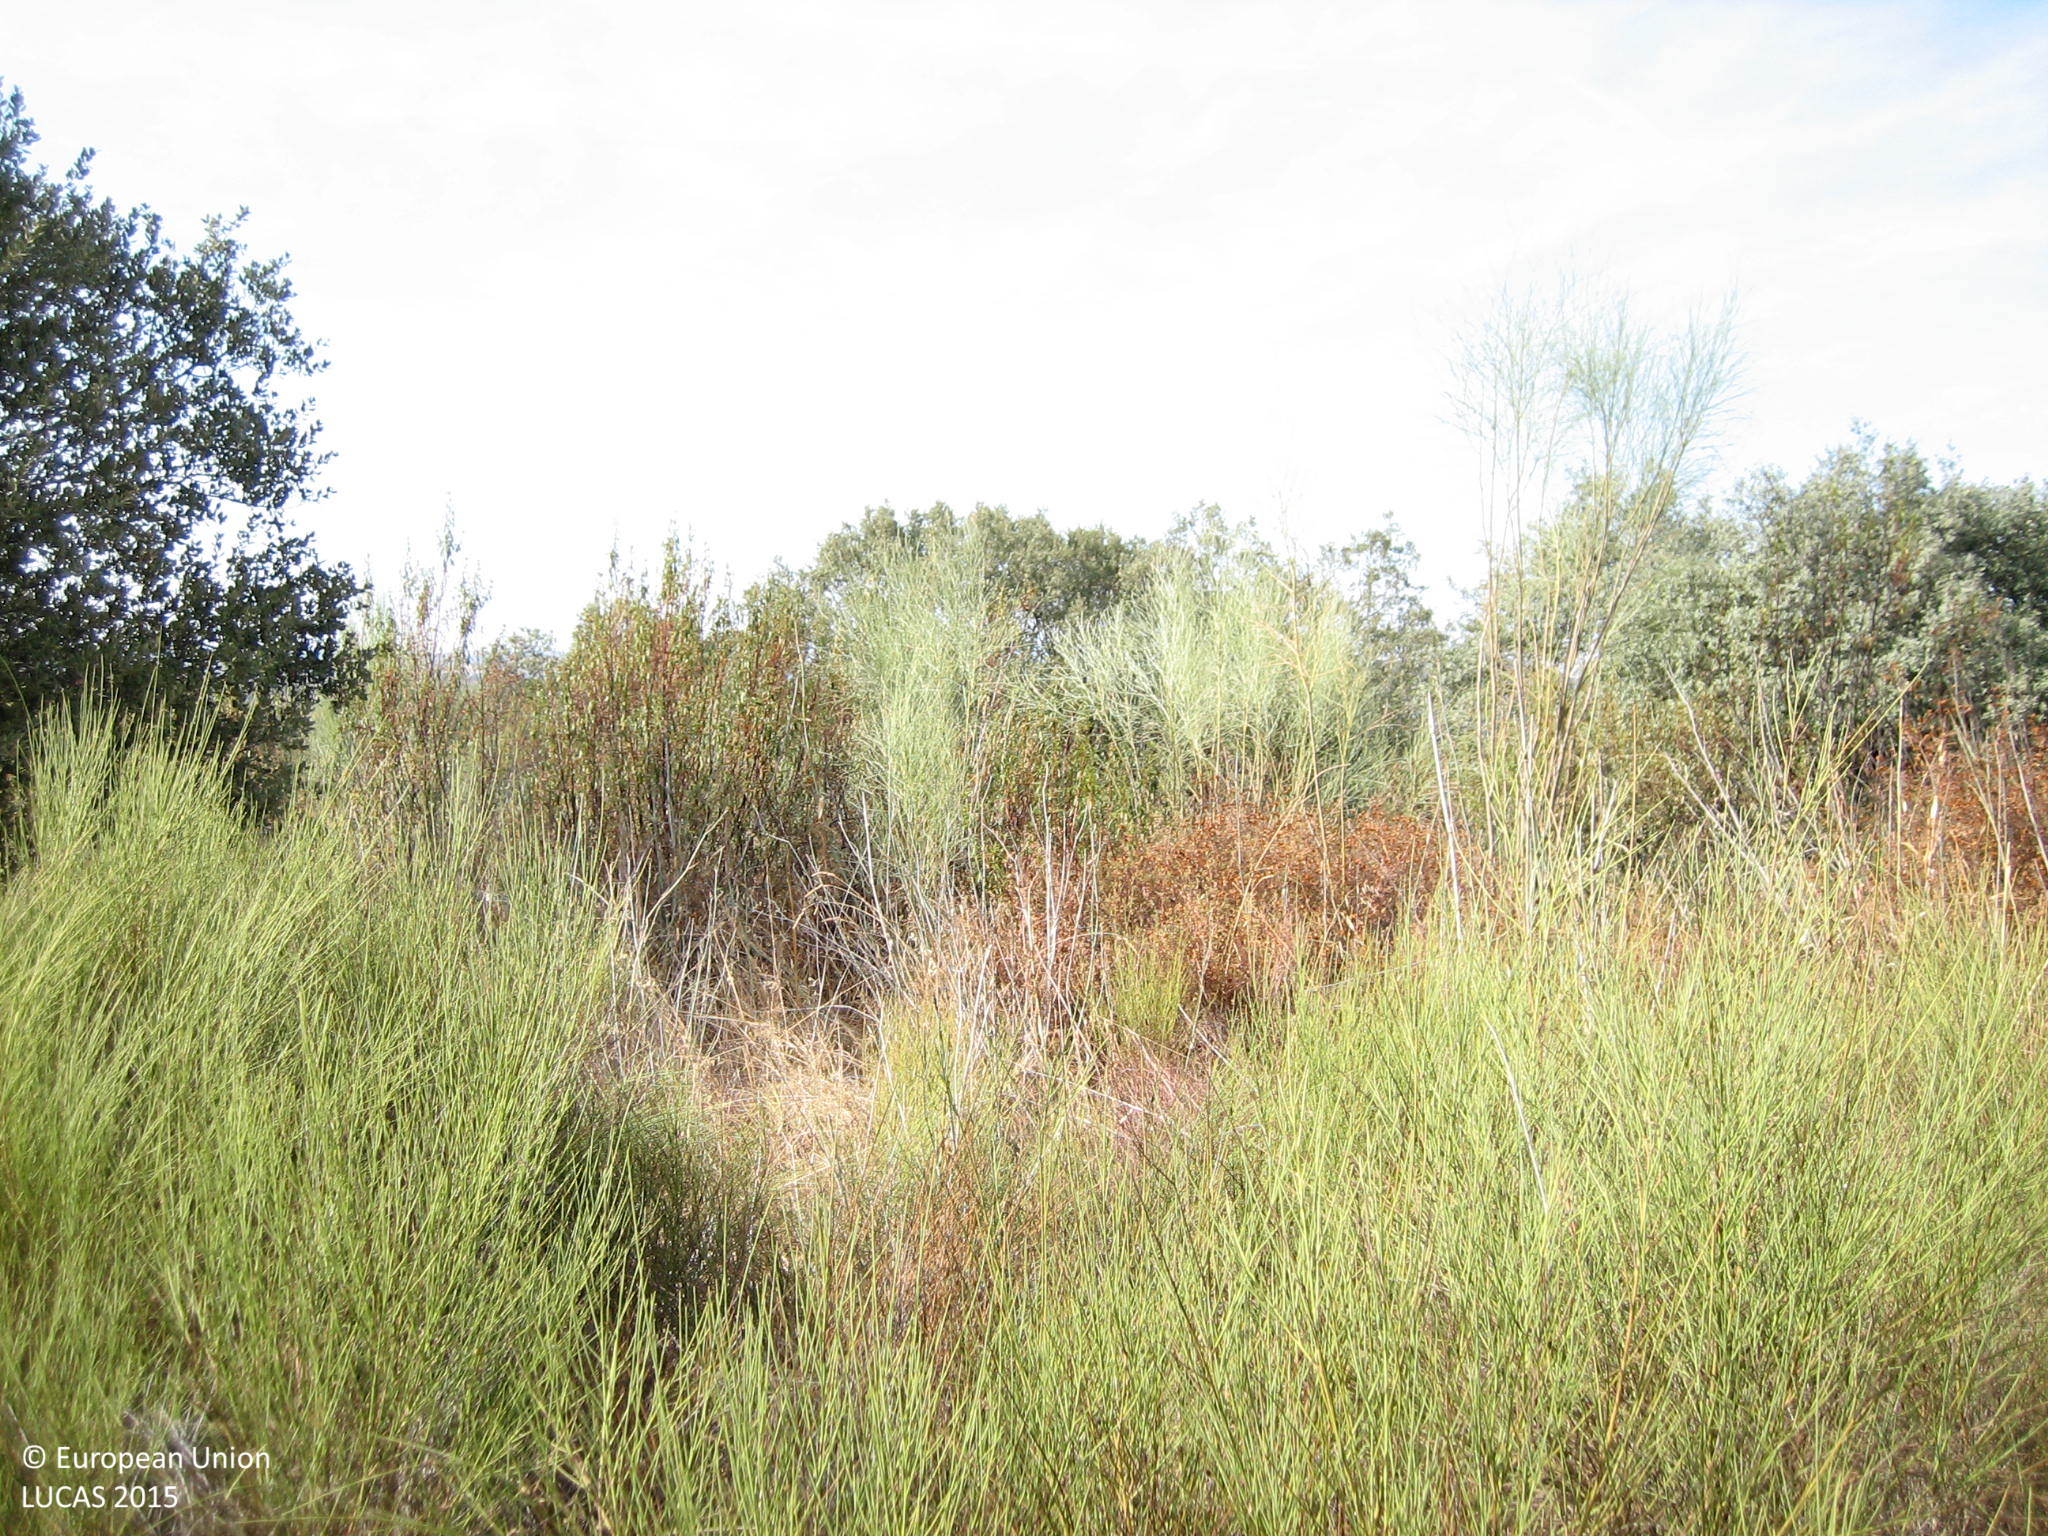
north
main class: Woodland
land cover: Broadleaved woodland
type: broadleaved evergreen forest
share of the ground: 50 - 75 %
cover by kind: broadleaved forest trees 50 %, shrubs 30 %, herbaceous plants 20 %
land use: Forestry
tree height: > 5 m
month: September
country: ES
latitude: 38.2014
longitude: -6.7827
